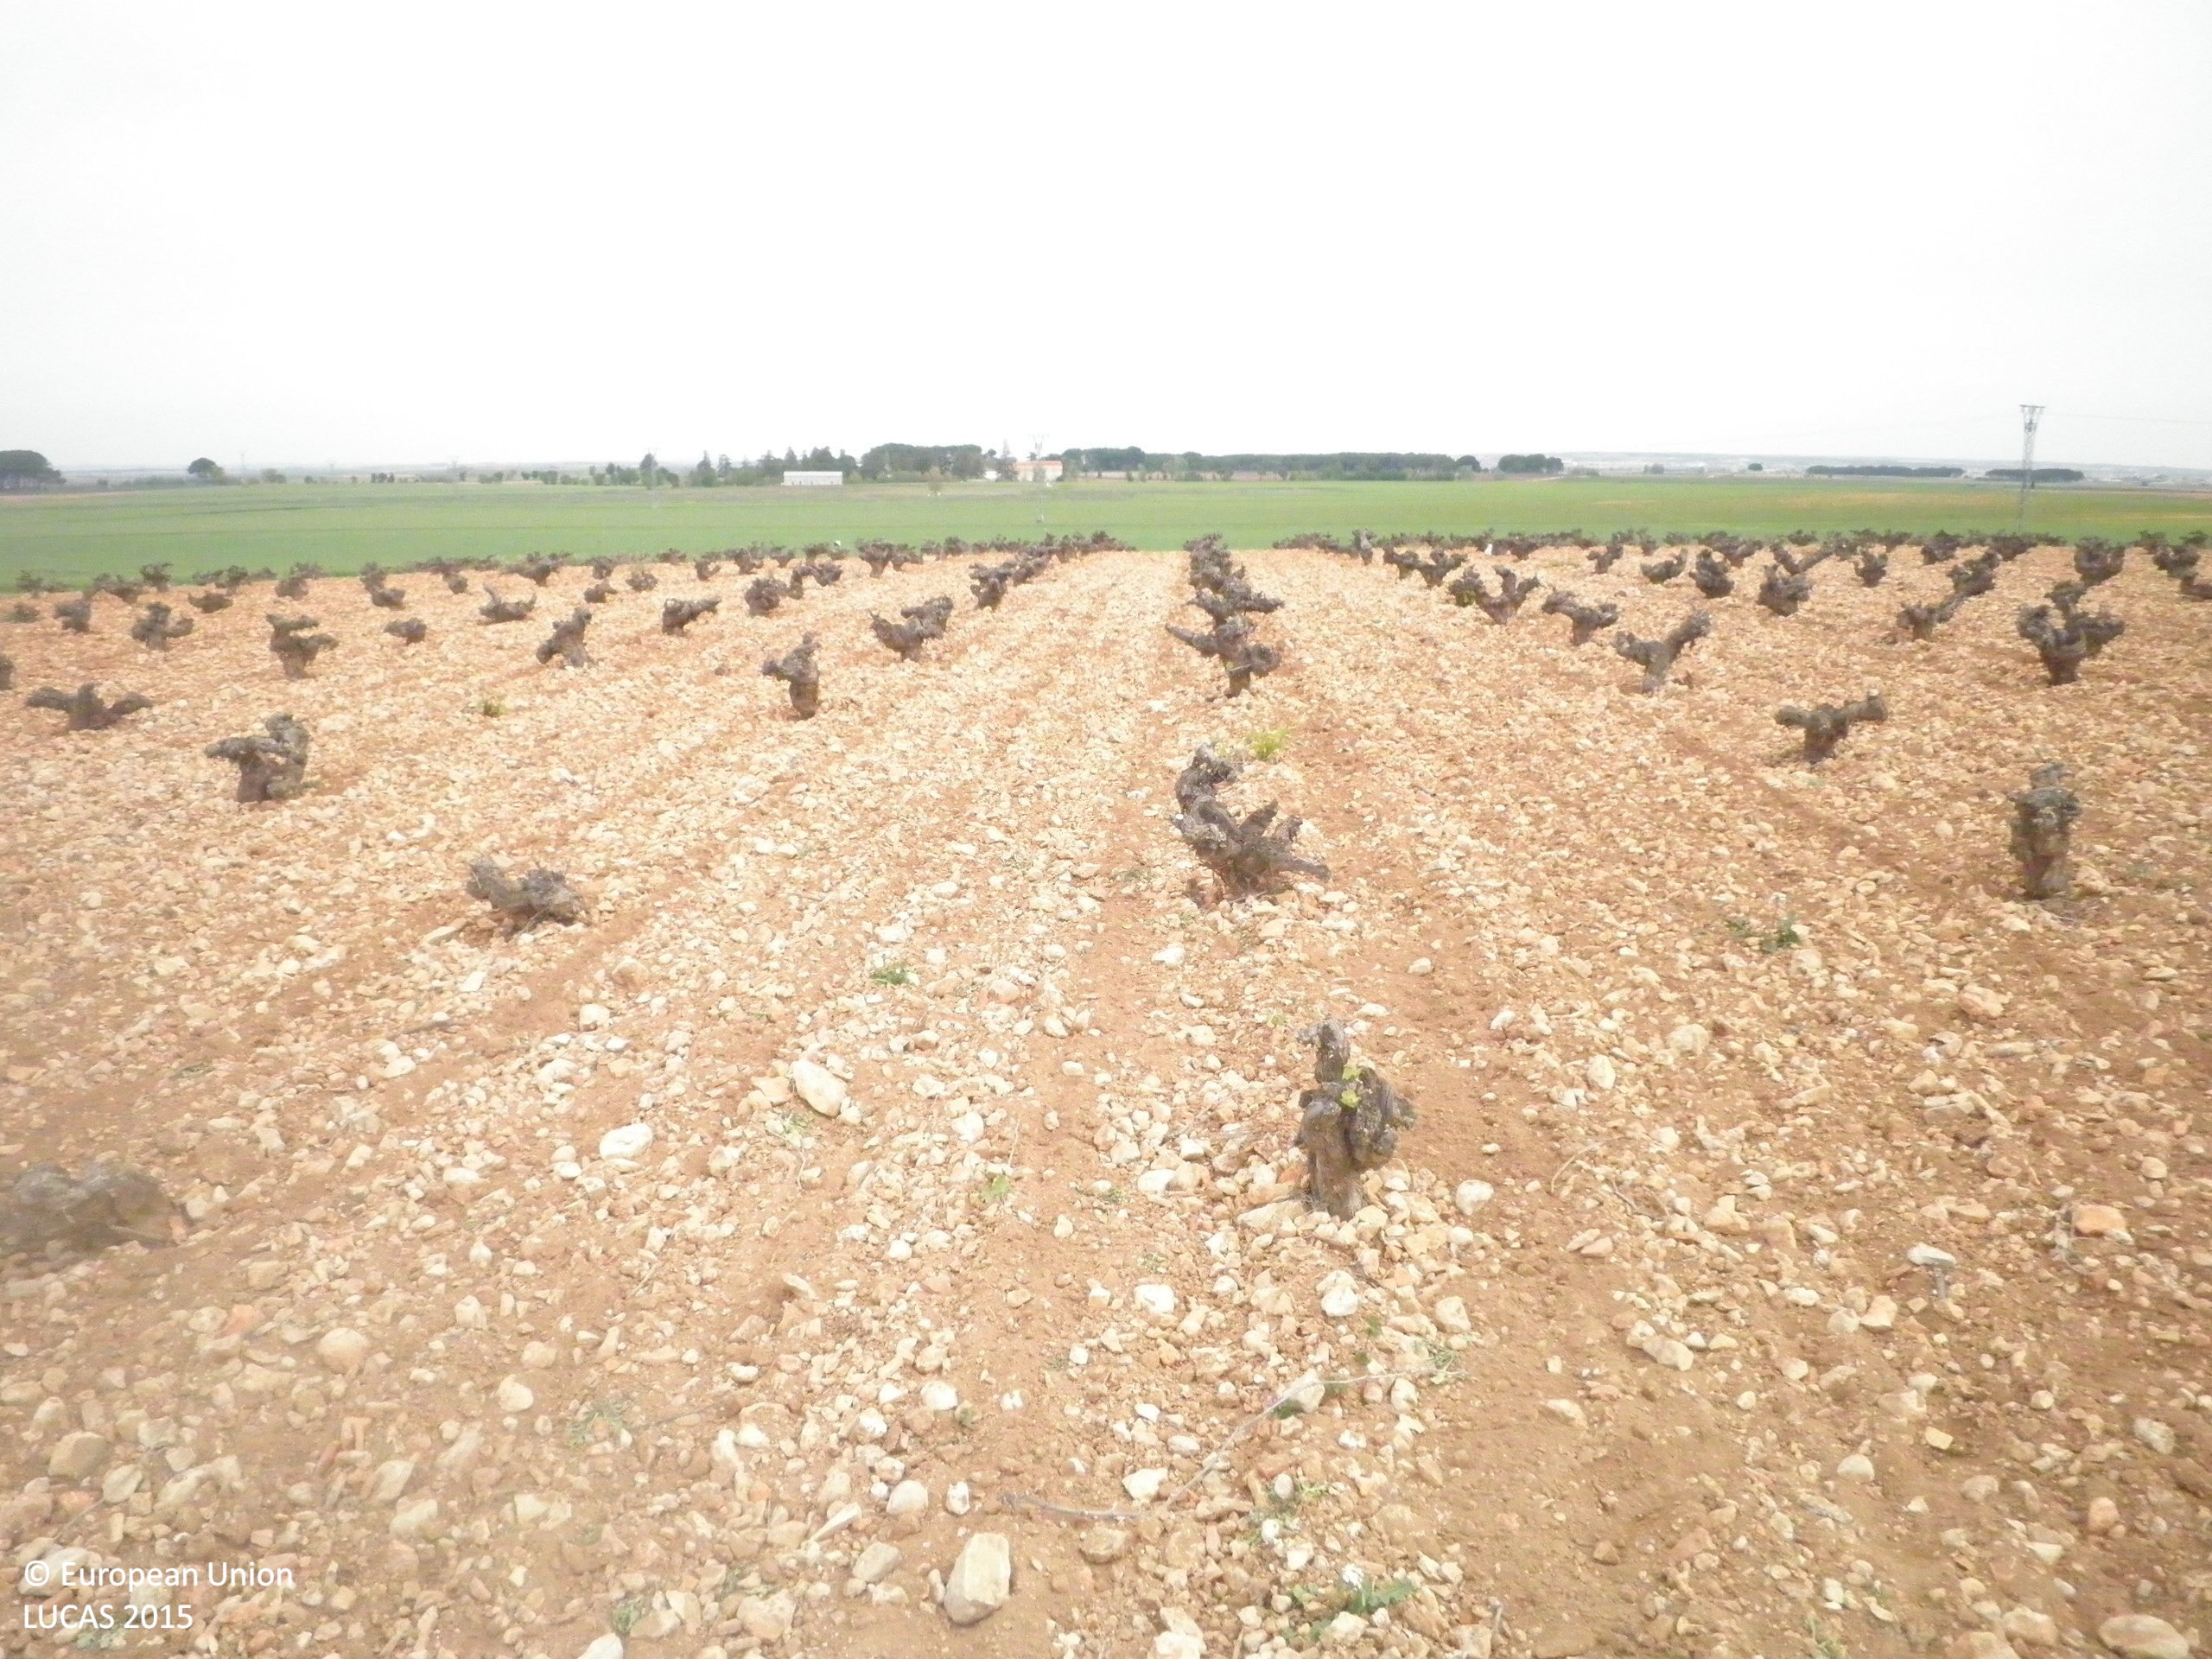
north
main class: Cropland
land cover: Vineyards
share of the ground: < 10 %
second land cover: Other bare soil
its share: > 75 %
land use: Agriculture (excluding fallow land and kitchen gardens)
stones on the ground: > 50 %
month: April
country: ES
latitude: 39.4011
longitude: -2.7053
